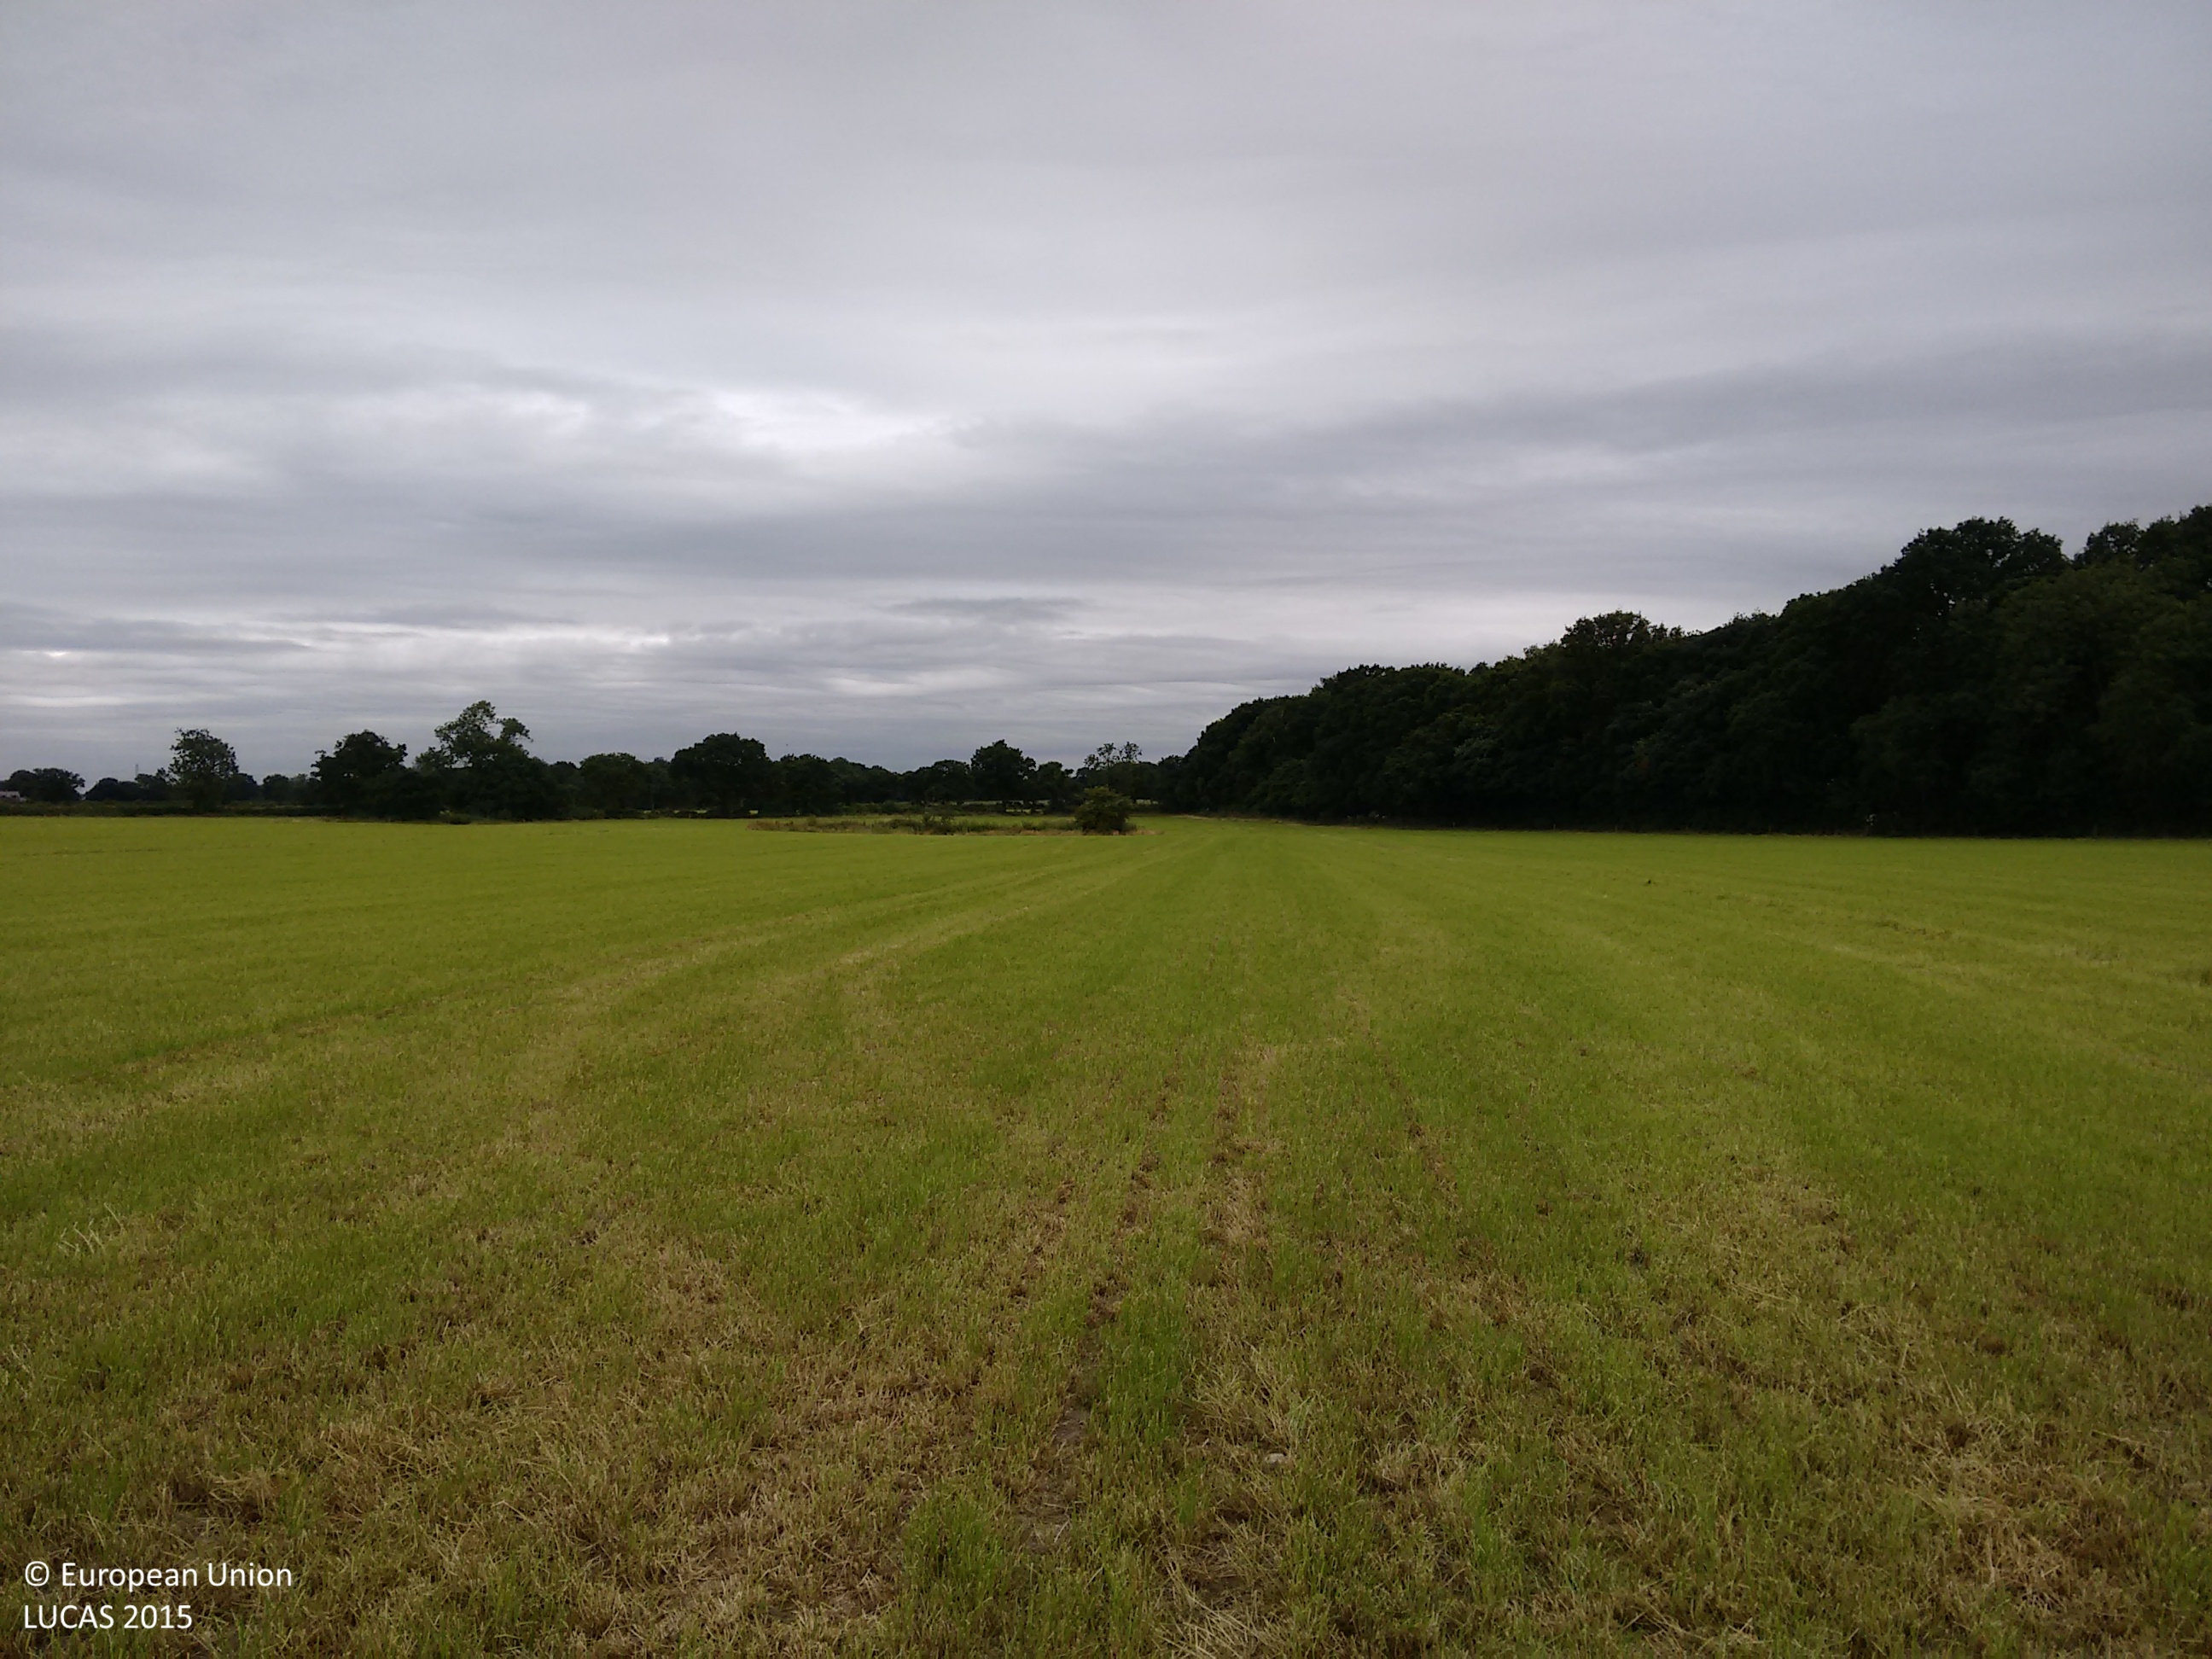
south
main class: Grassland
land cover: Grassland without tree/shrub cover
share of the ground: > 75 %
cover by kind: herbaceous plants 100 %
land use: Agriculture (excluding fallow land and kitchen gardens)
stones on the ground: < 10 %
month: July
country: GB
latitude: 53.3175
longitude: -2.4794
